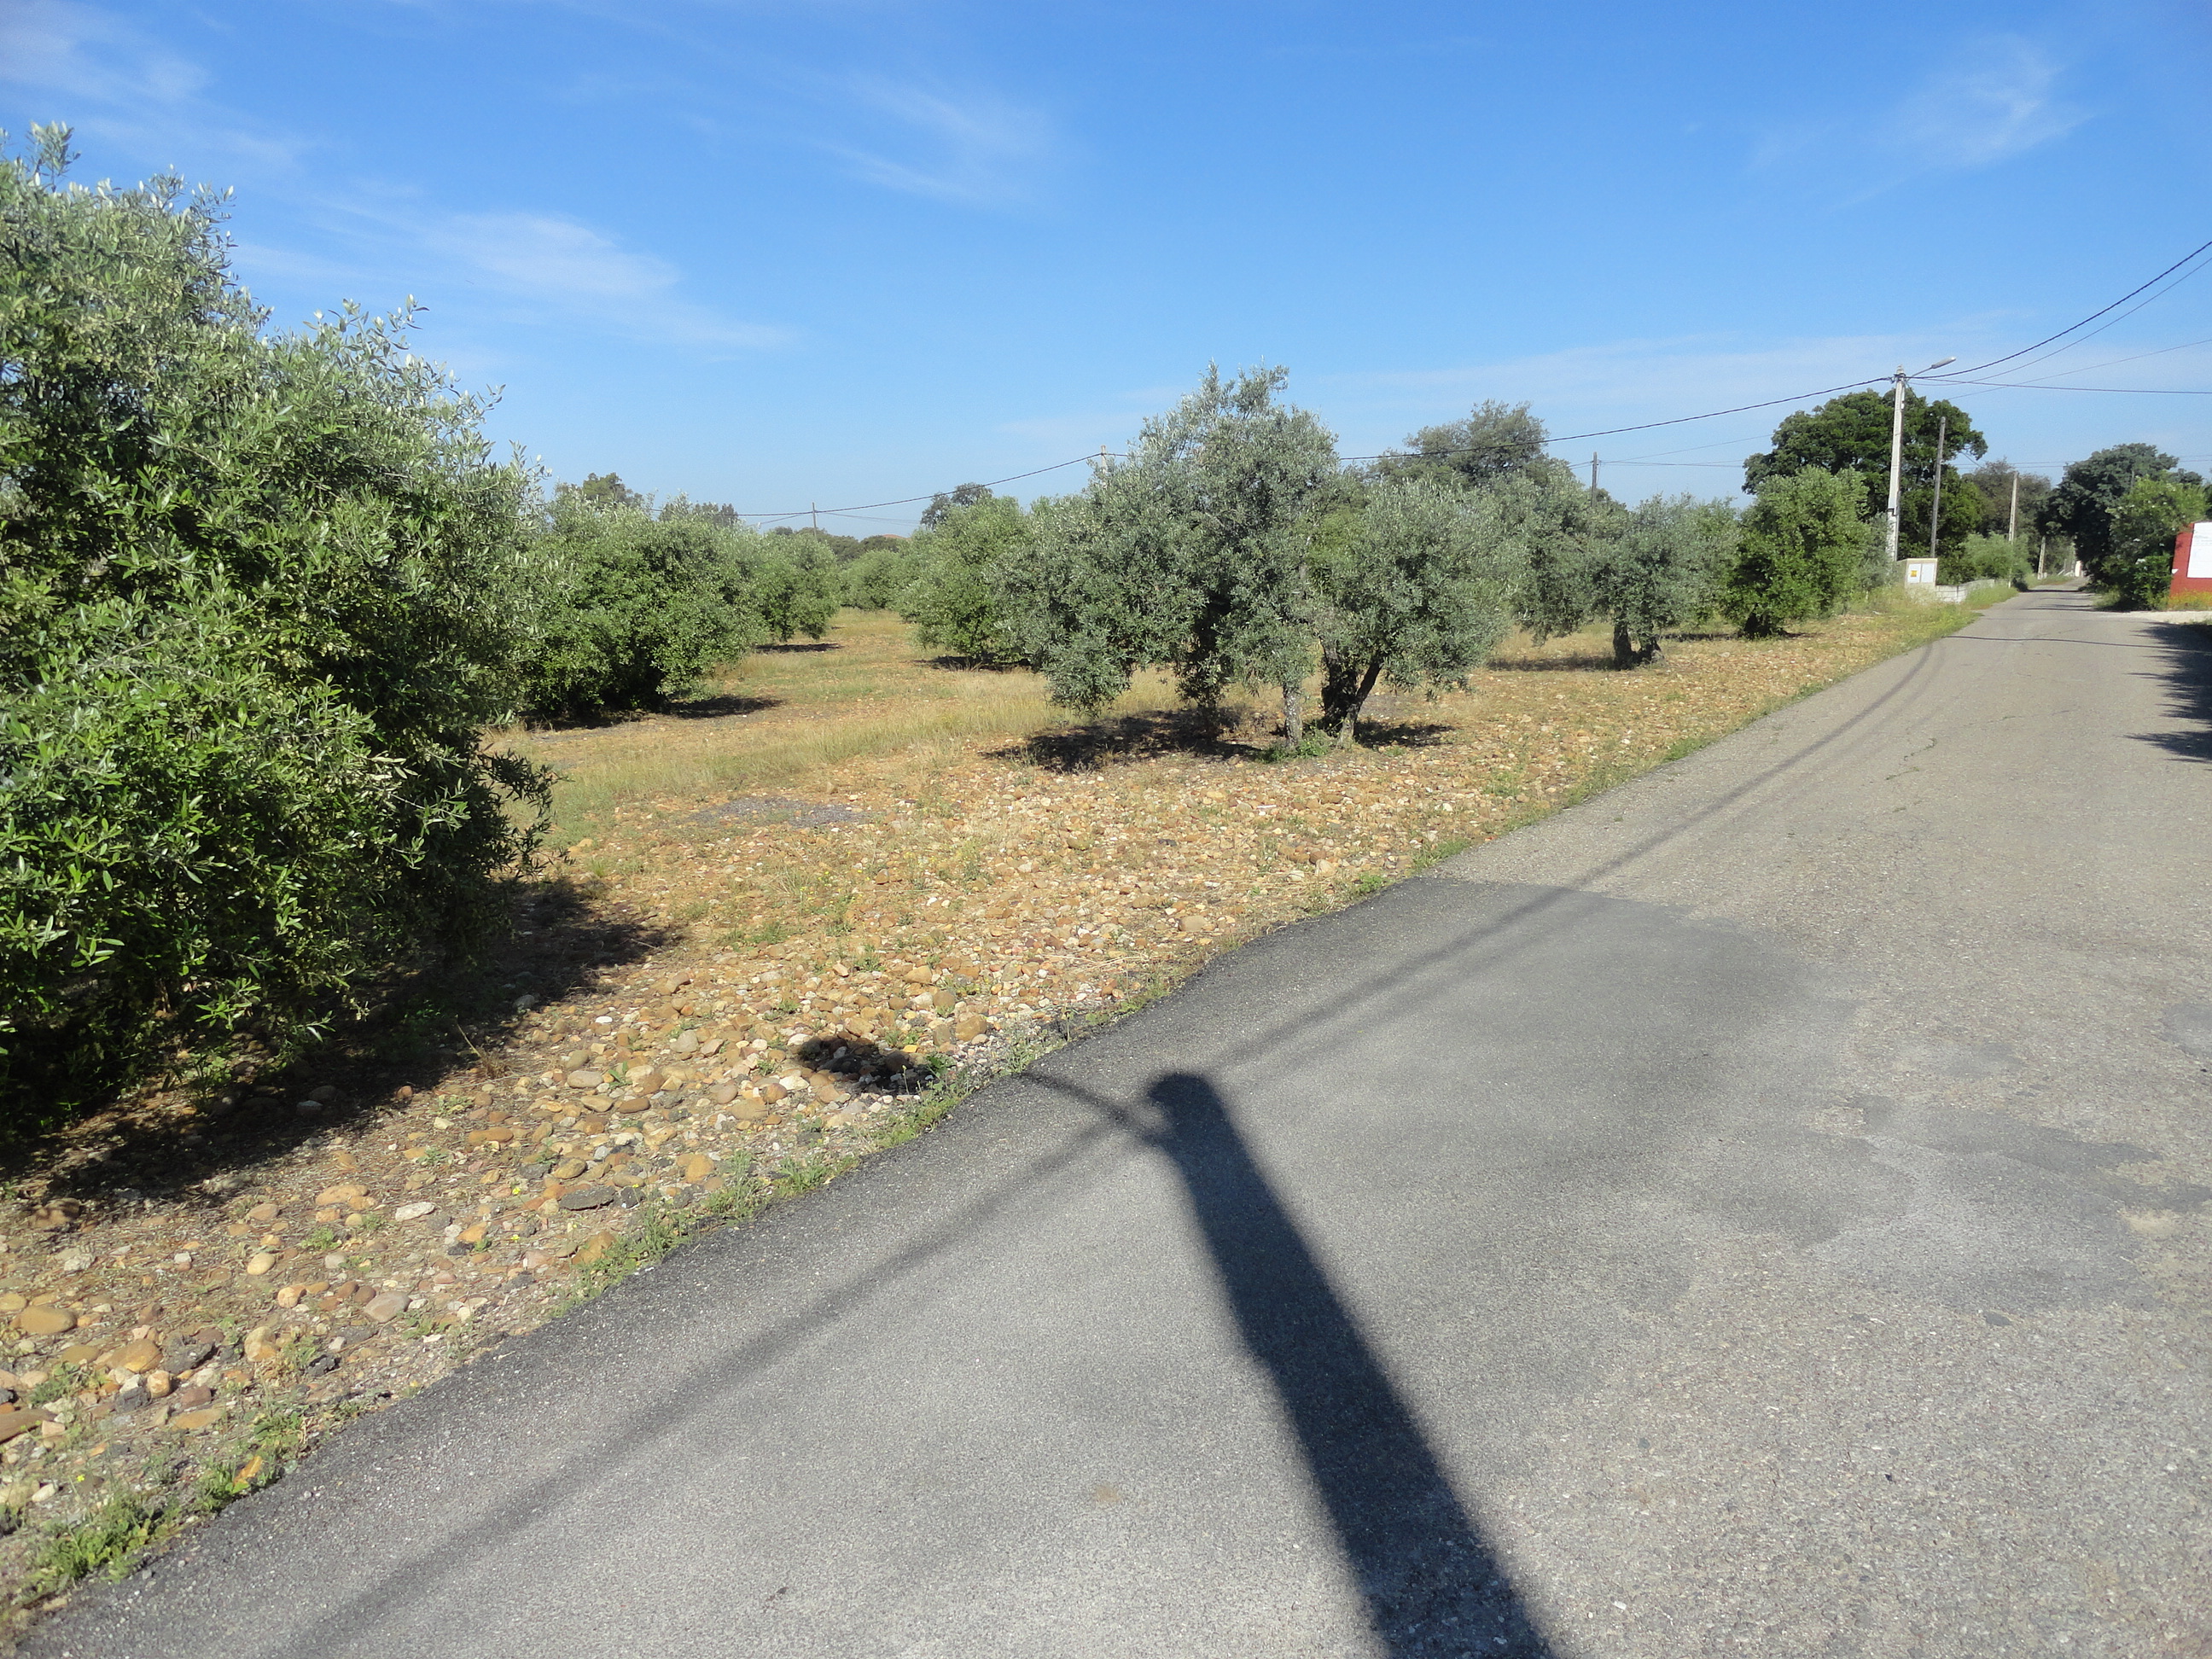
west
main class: Cropland
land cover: Olive groves
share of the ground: 10 - 25 %
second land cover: Other bare soil
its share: > 75 %
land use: Kitchen garden
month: May
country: ES
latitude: 37.7098
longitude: -4.8840
